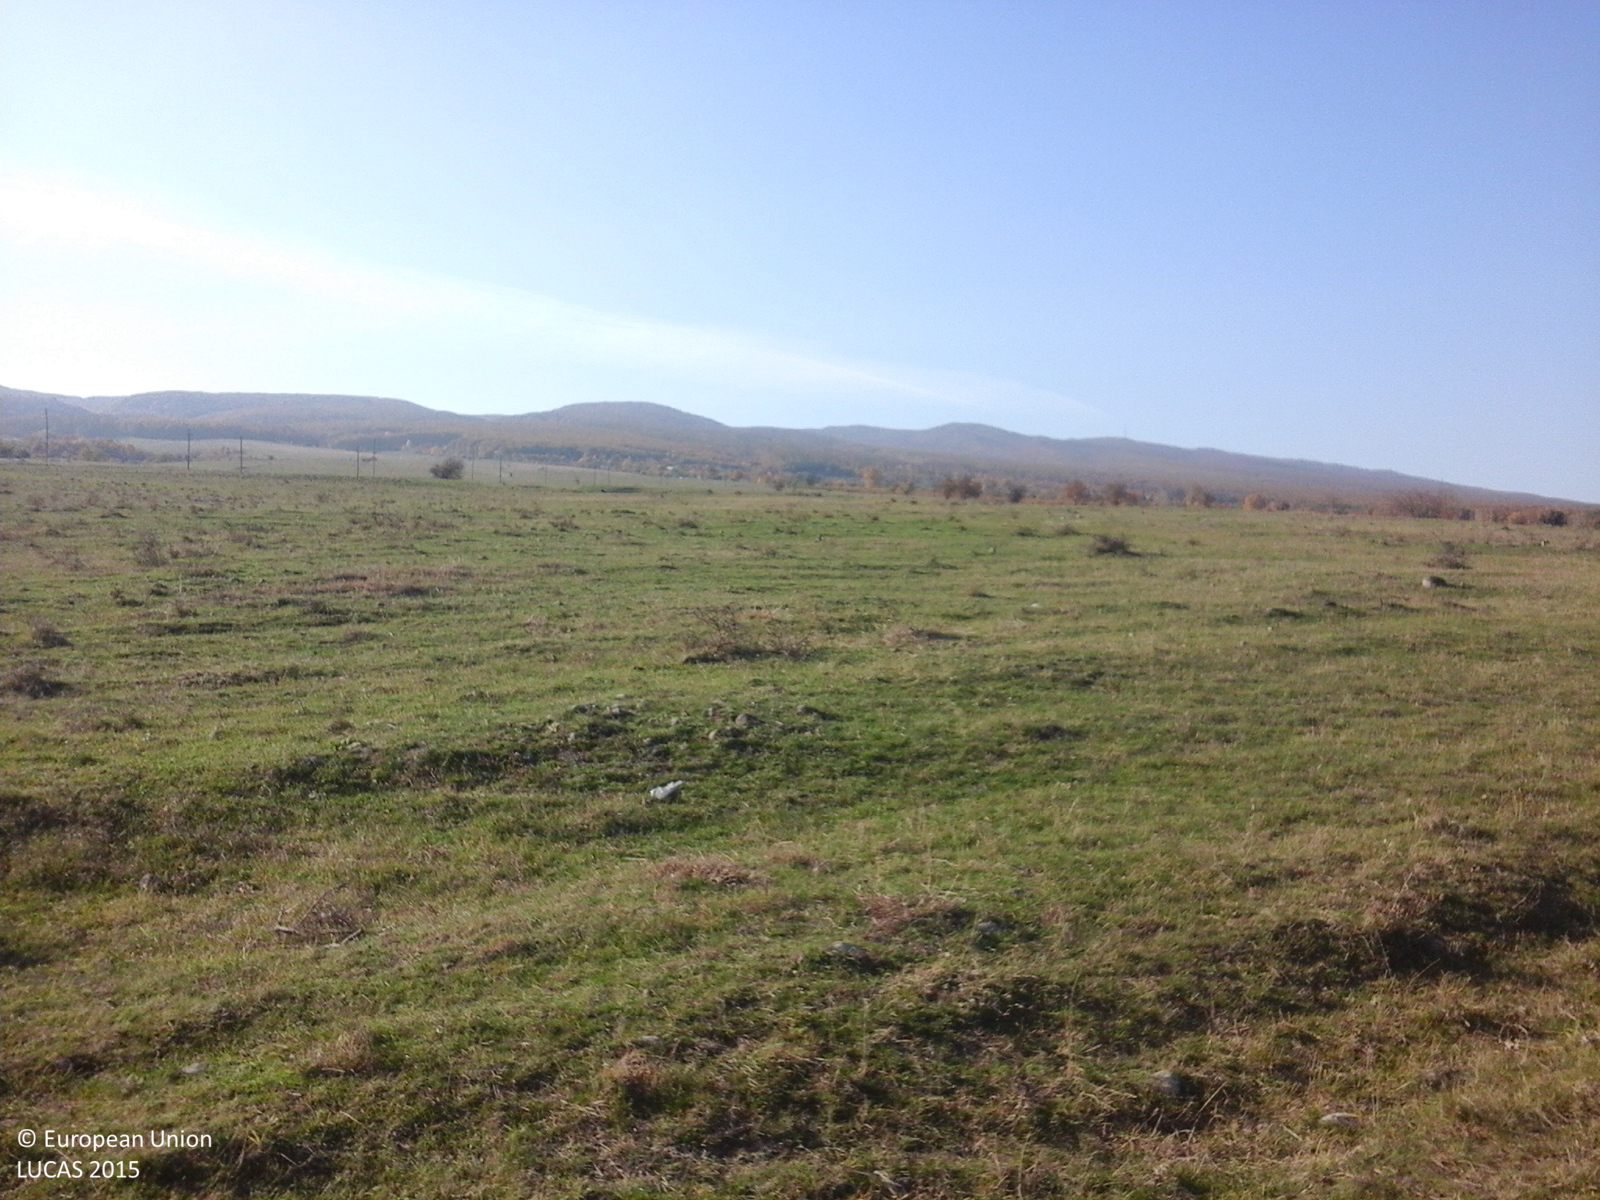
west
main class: Grassland
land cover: Grassland without tree/shrub cover
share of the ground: > 75 %
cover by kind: herbaceous plants 100 %
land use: Agriculture (excluding fallow land and kitchen gardens)
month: October
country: RO
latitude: 45.8167
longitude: 27.0415
